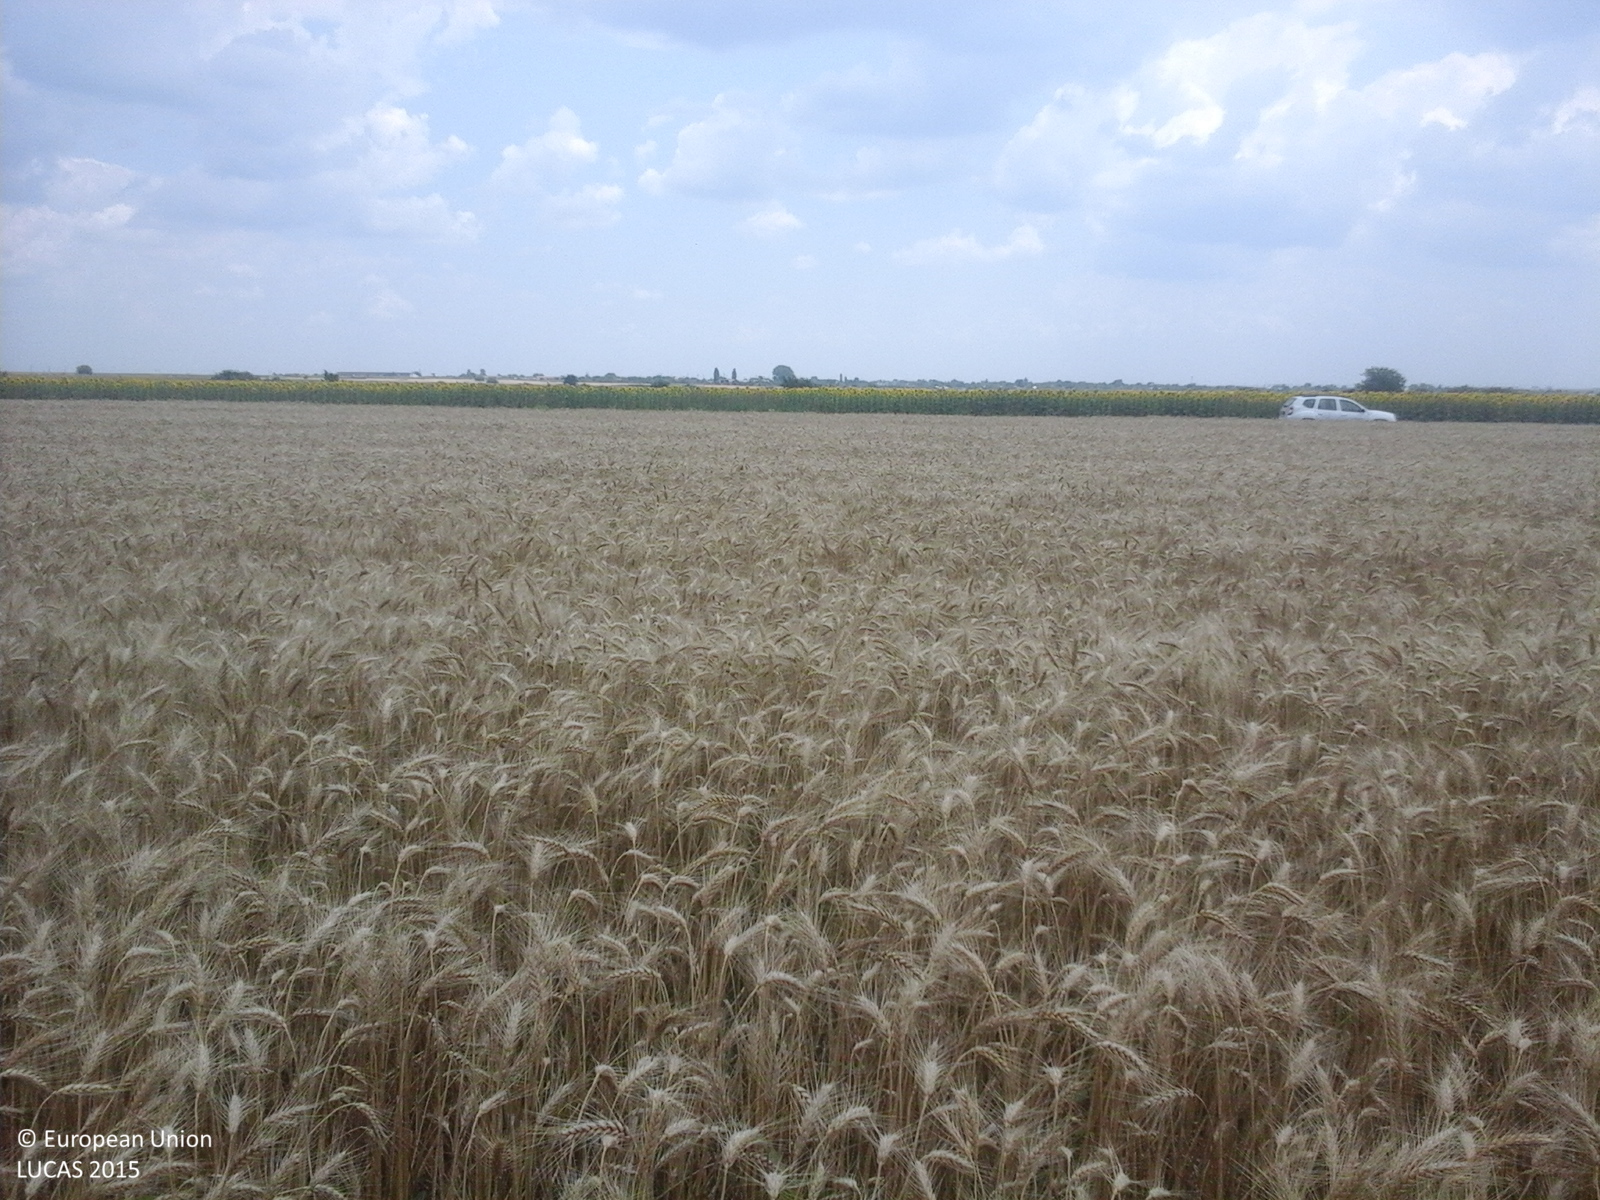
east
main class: Cropland
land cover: Sunflower
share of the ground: > 75 %
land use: Agriculture (excluding fallow land and kitchen gardens)
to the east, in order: Sunflower; Common wheat; Tracks; Sunflower; Common wheat; Spontaneously vegetated surfaces; Other non-permanent industrial crops
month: July
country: RO
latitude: 43.8902
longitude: 25.6362
